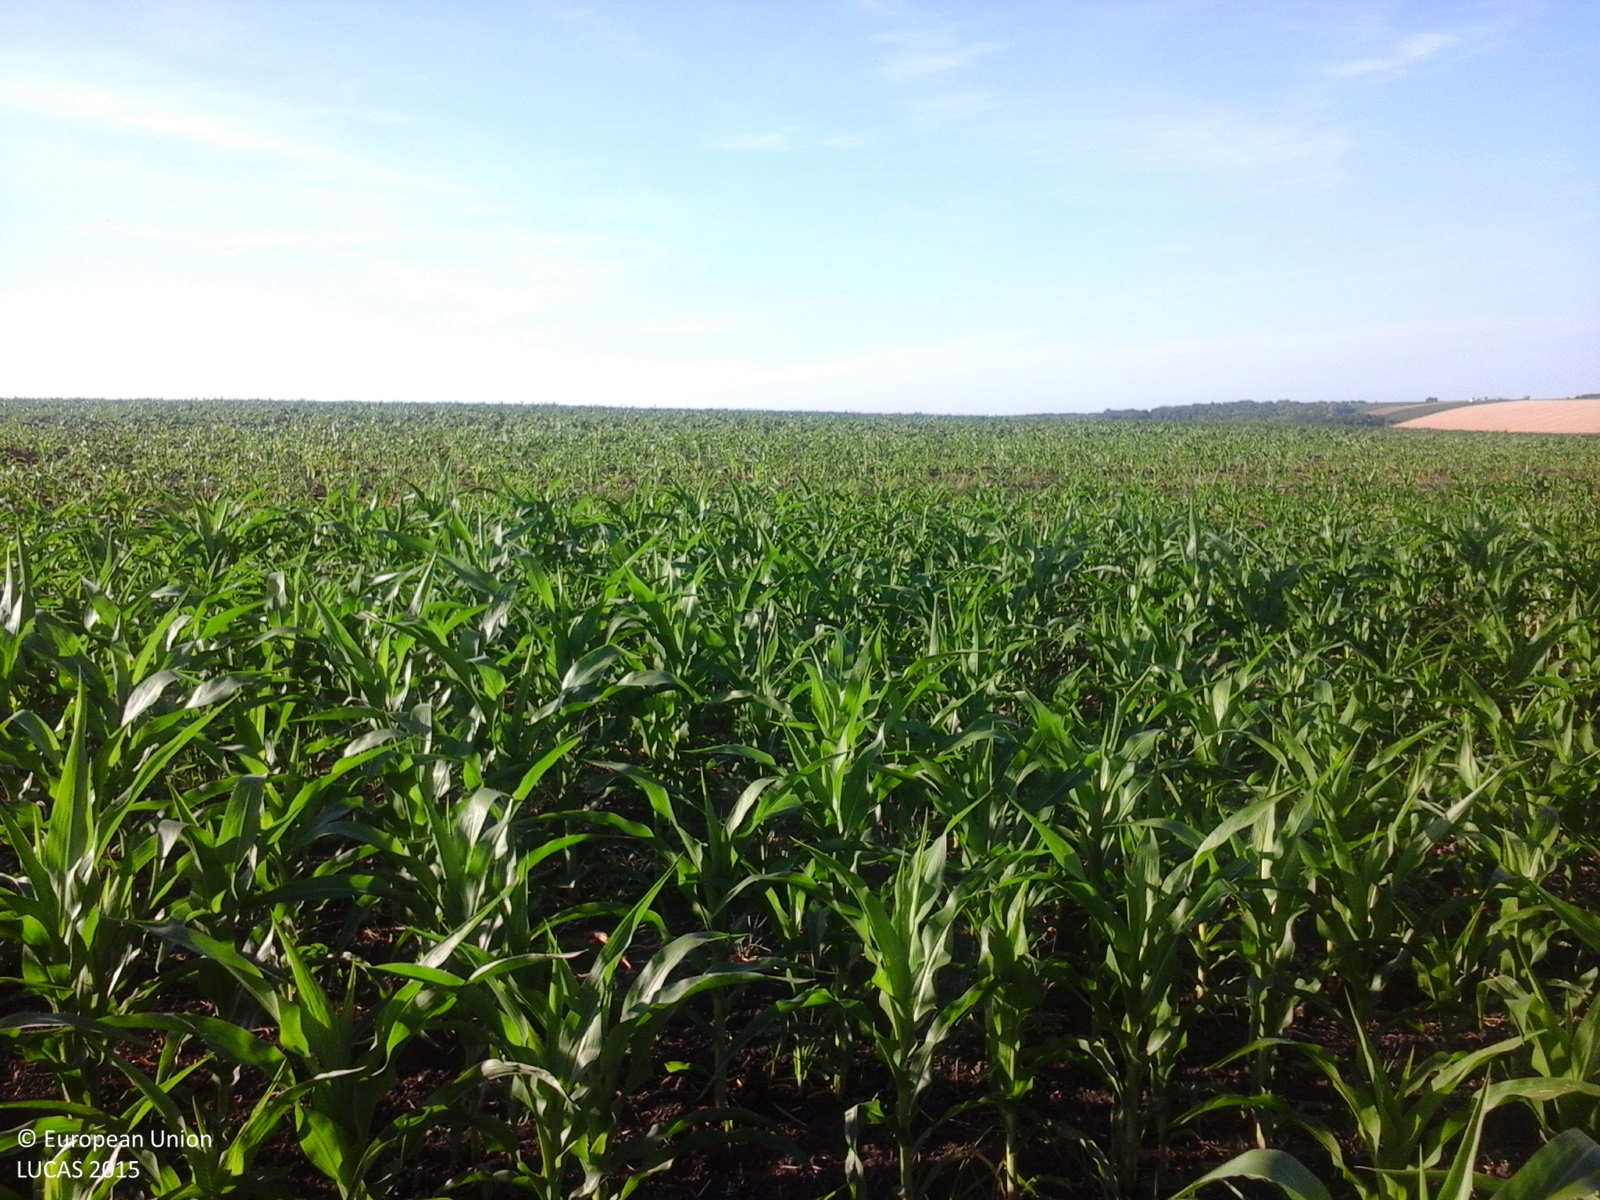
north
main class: Cropland
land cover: Maize
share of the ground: 50 - 75 %
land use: Agriculture (excluding fallow land and kitchen gardens)
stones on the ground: < 10 %
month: June
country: RO
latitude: 47.3199
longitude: 27.1875
